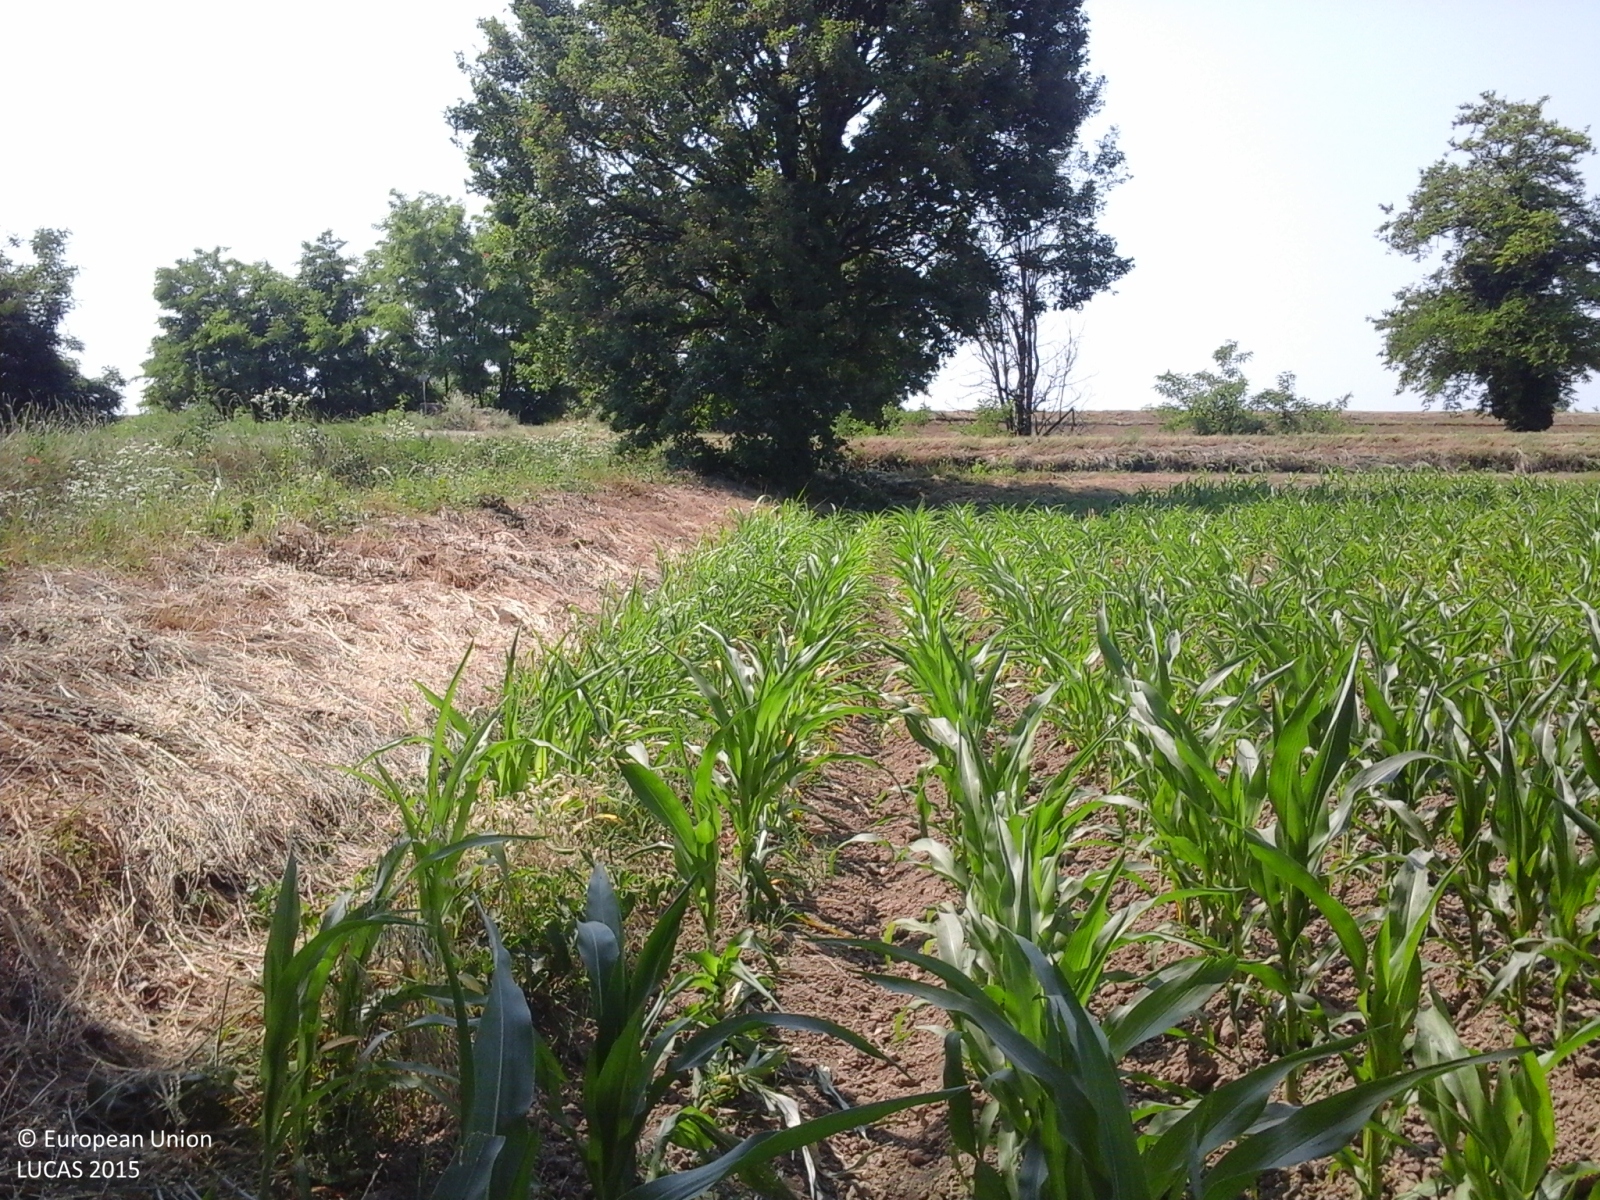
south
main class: Cropland
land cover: Maize
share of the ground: 50 - 75 %
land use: Agriculture (excluding fallow land and kitchen gardens)
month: June
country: IT
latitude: 45.1439
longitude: 9.9111
